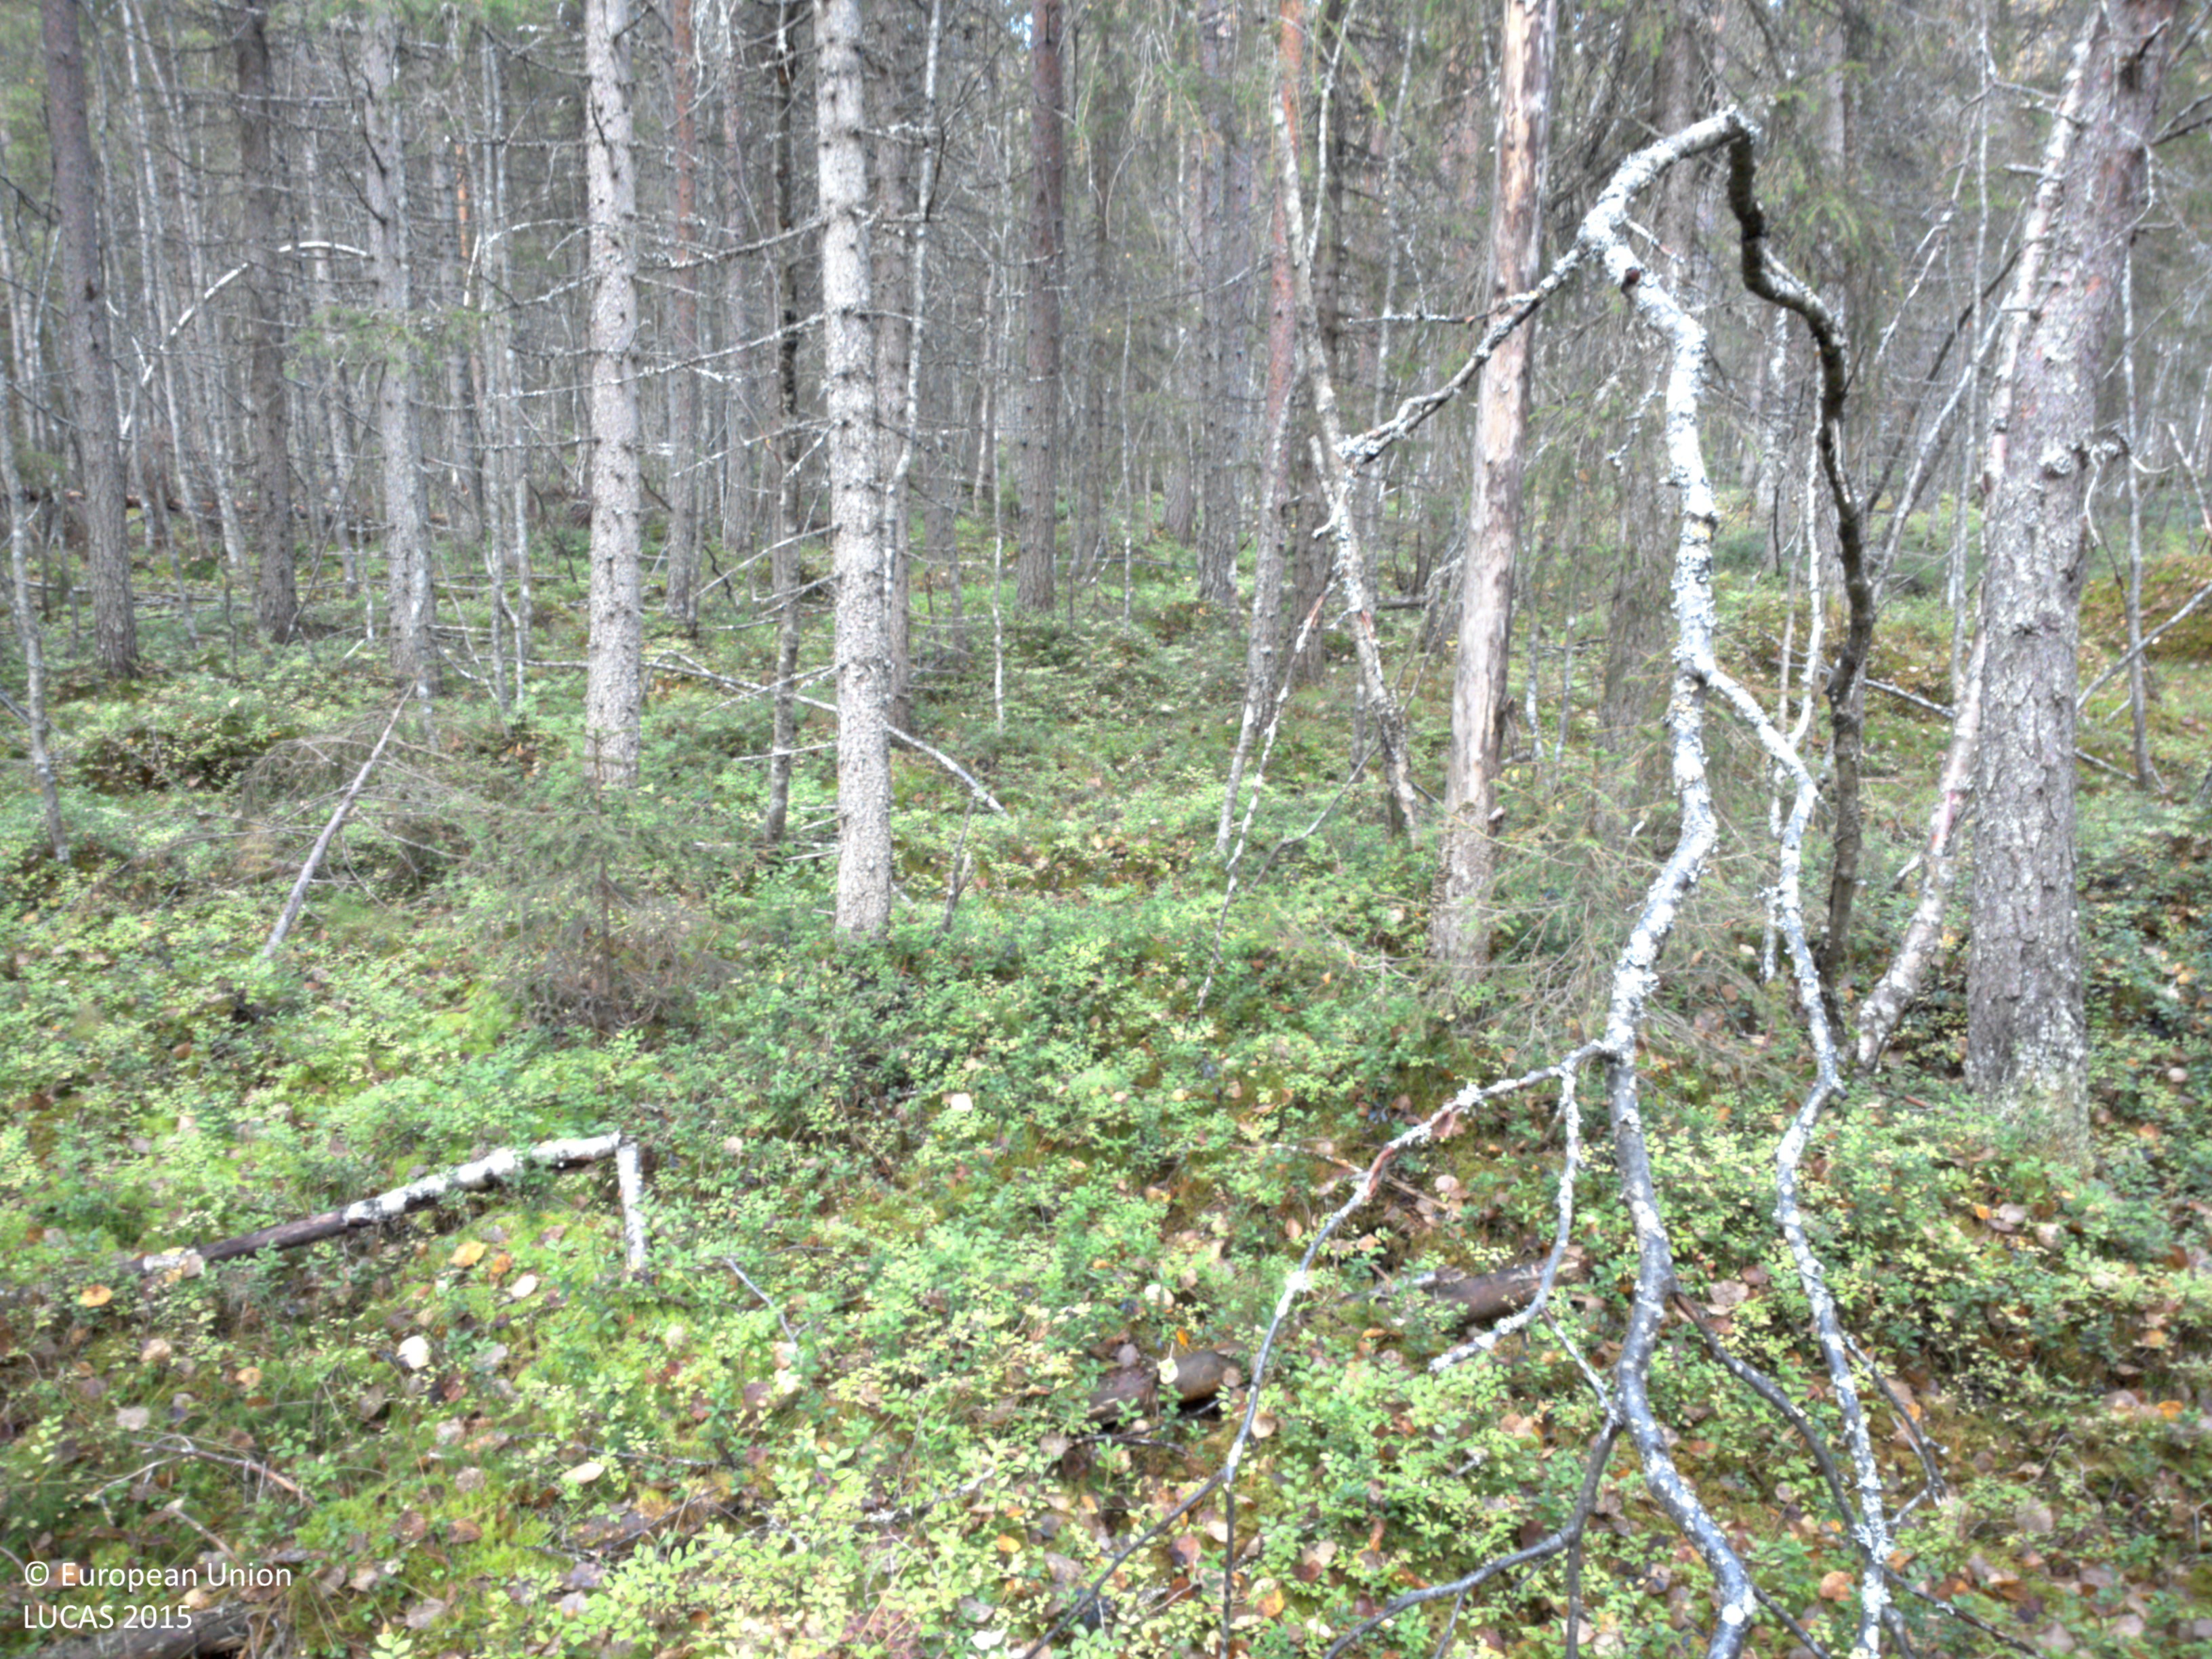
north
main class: Woodland
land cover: Spruce dominated coniferous woodland
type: boreal forest
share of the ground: > 75 %
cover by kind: coniferous forest trees 80 %, shrubs 10 %, broadleaved forest trees 5 %, lichens and mosses 5 %
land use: Forestry
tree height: > 5 m
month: September
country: SE
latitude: 65.0841
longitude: 18.4090
